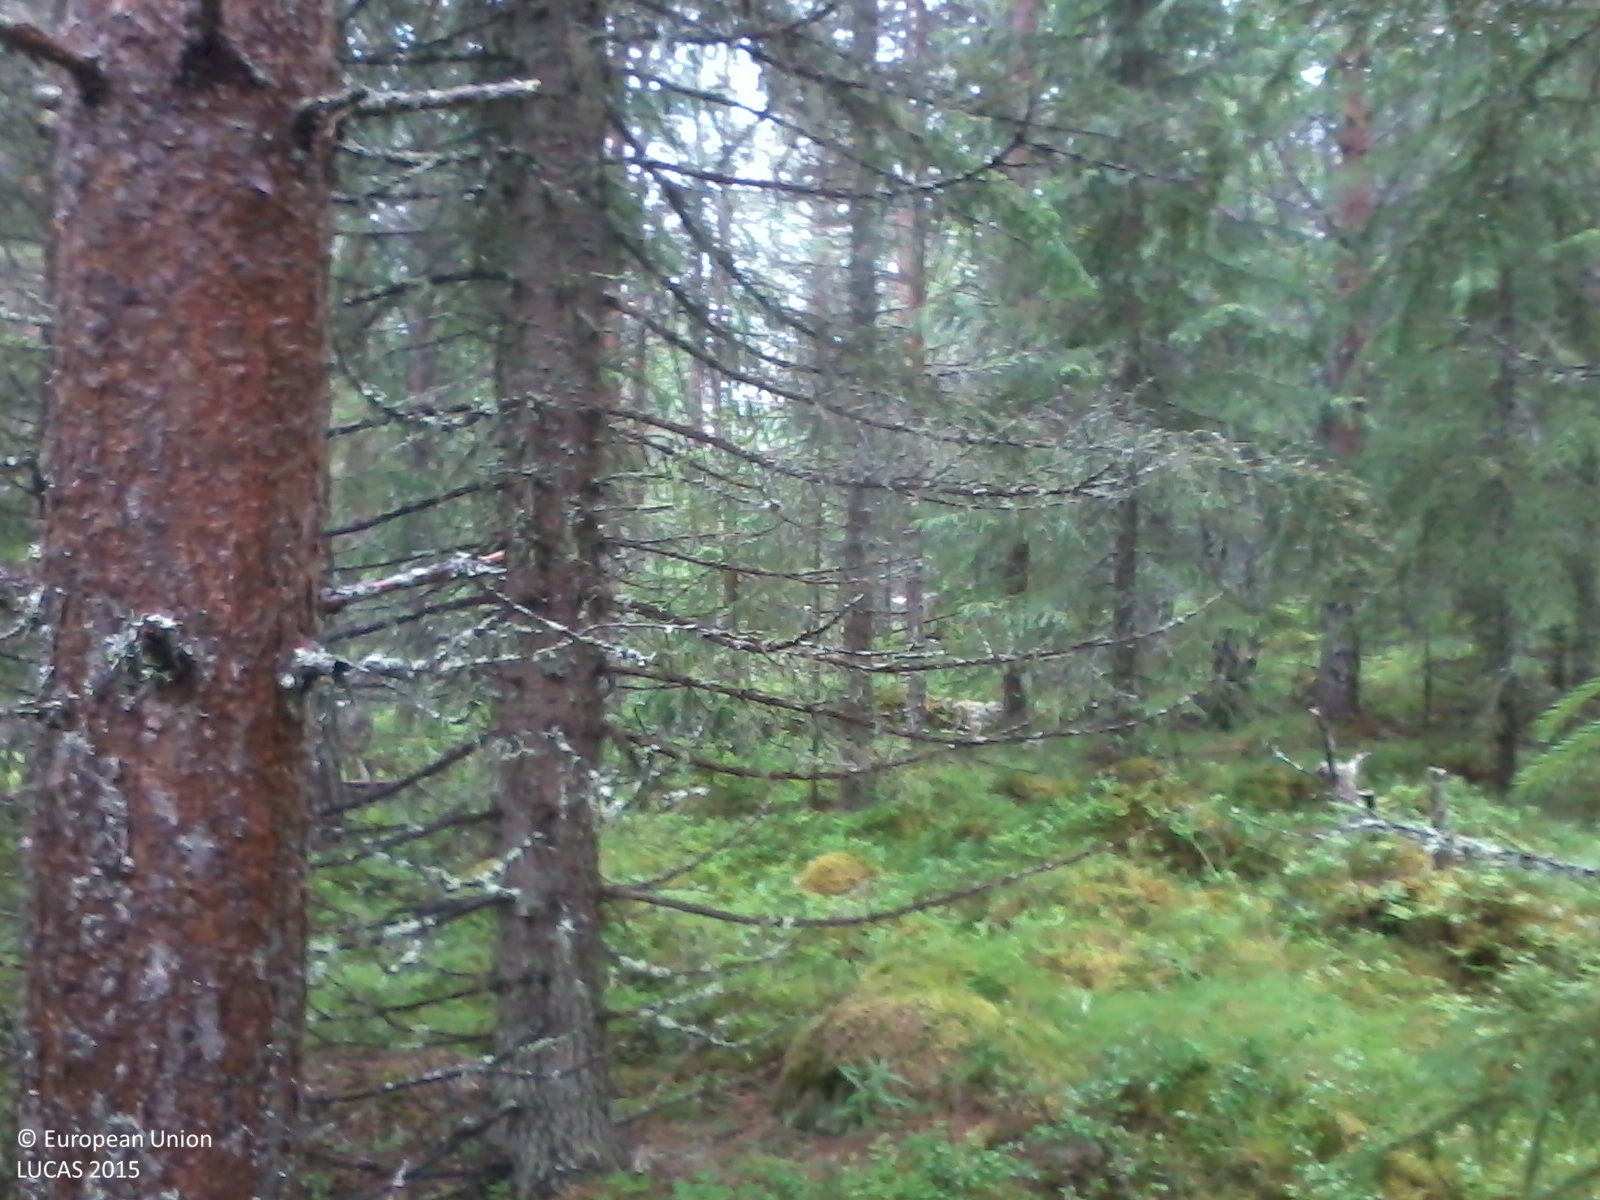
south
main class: Woodland
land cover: Pine dominated coniferous woodland
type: boreal forest
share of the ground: 50 - 75 %
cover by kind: coniferous forest trees 70 %, shrubs 30 %
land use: Forestry
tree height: > 5 m
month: August
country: SE
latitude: 62.8538
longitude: 16.8730
